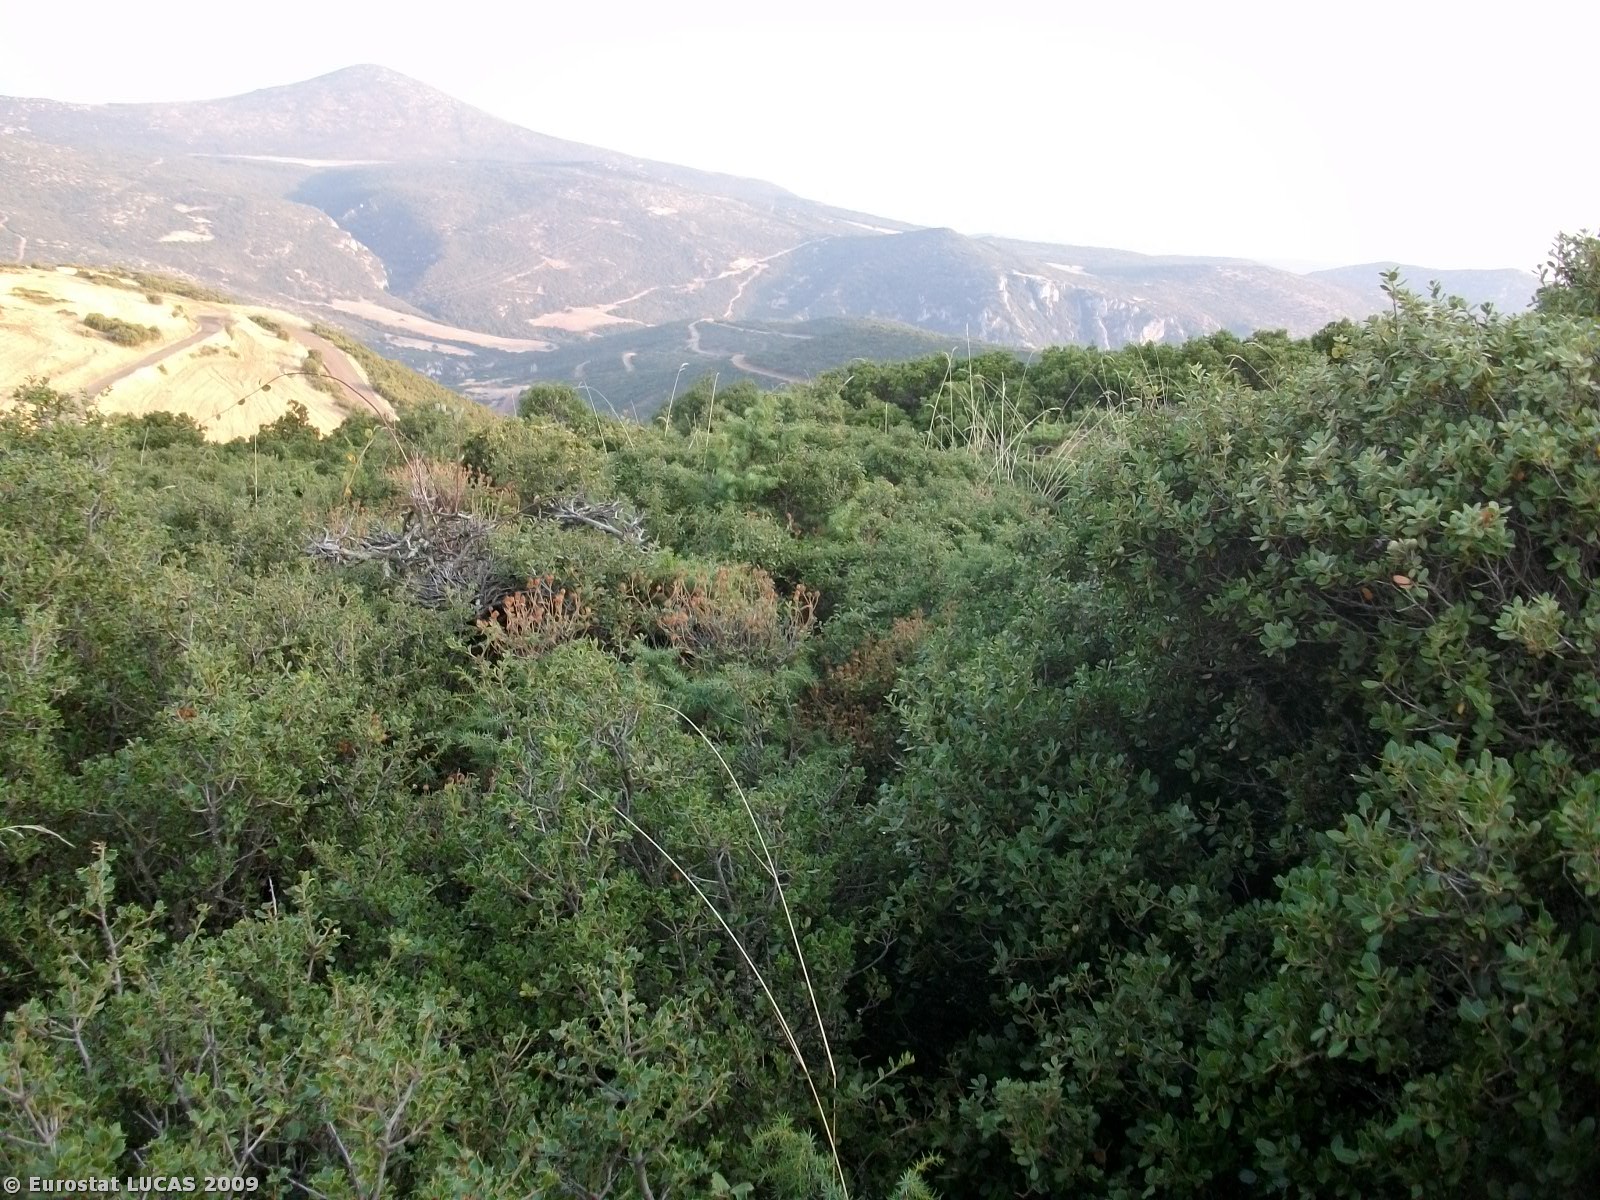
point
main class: Shrubland
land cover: Shrubland without tree cover
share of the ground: > 75 %
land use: Unused
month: August
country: GR
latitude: 38.9758
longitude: 22.4596
